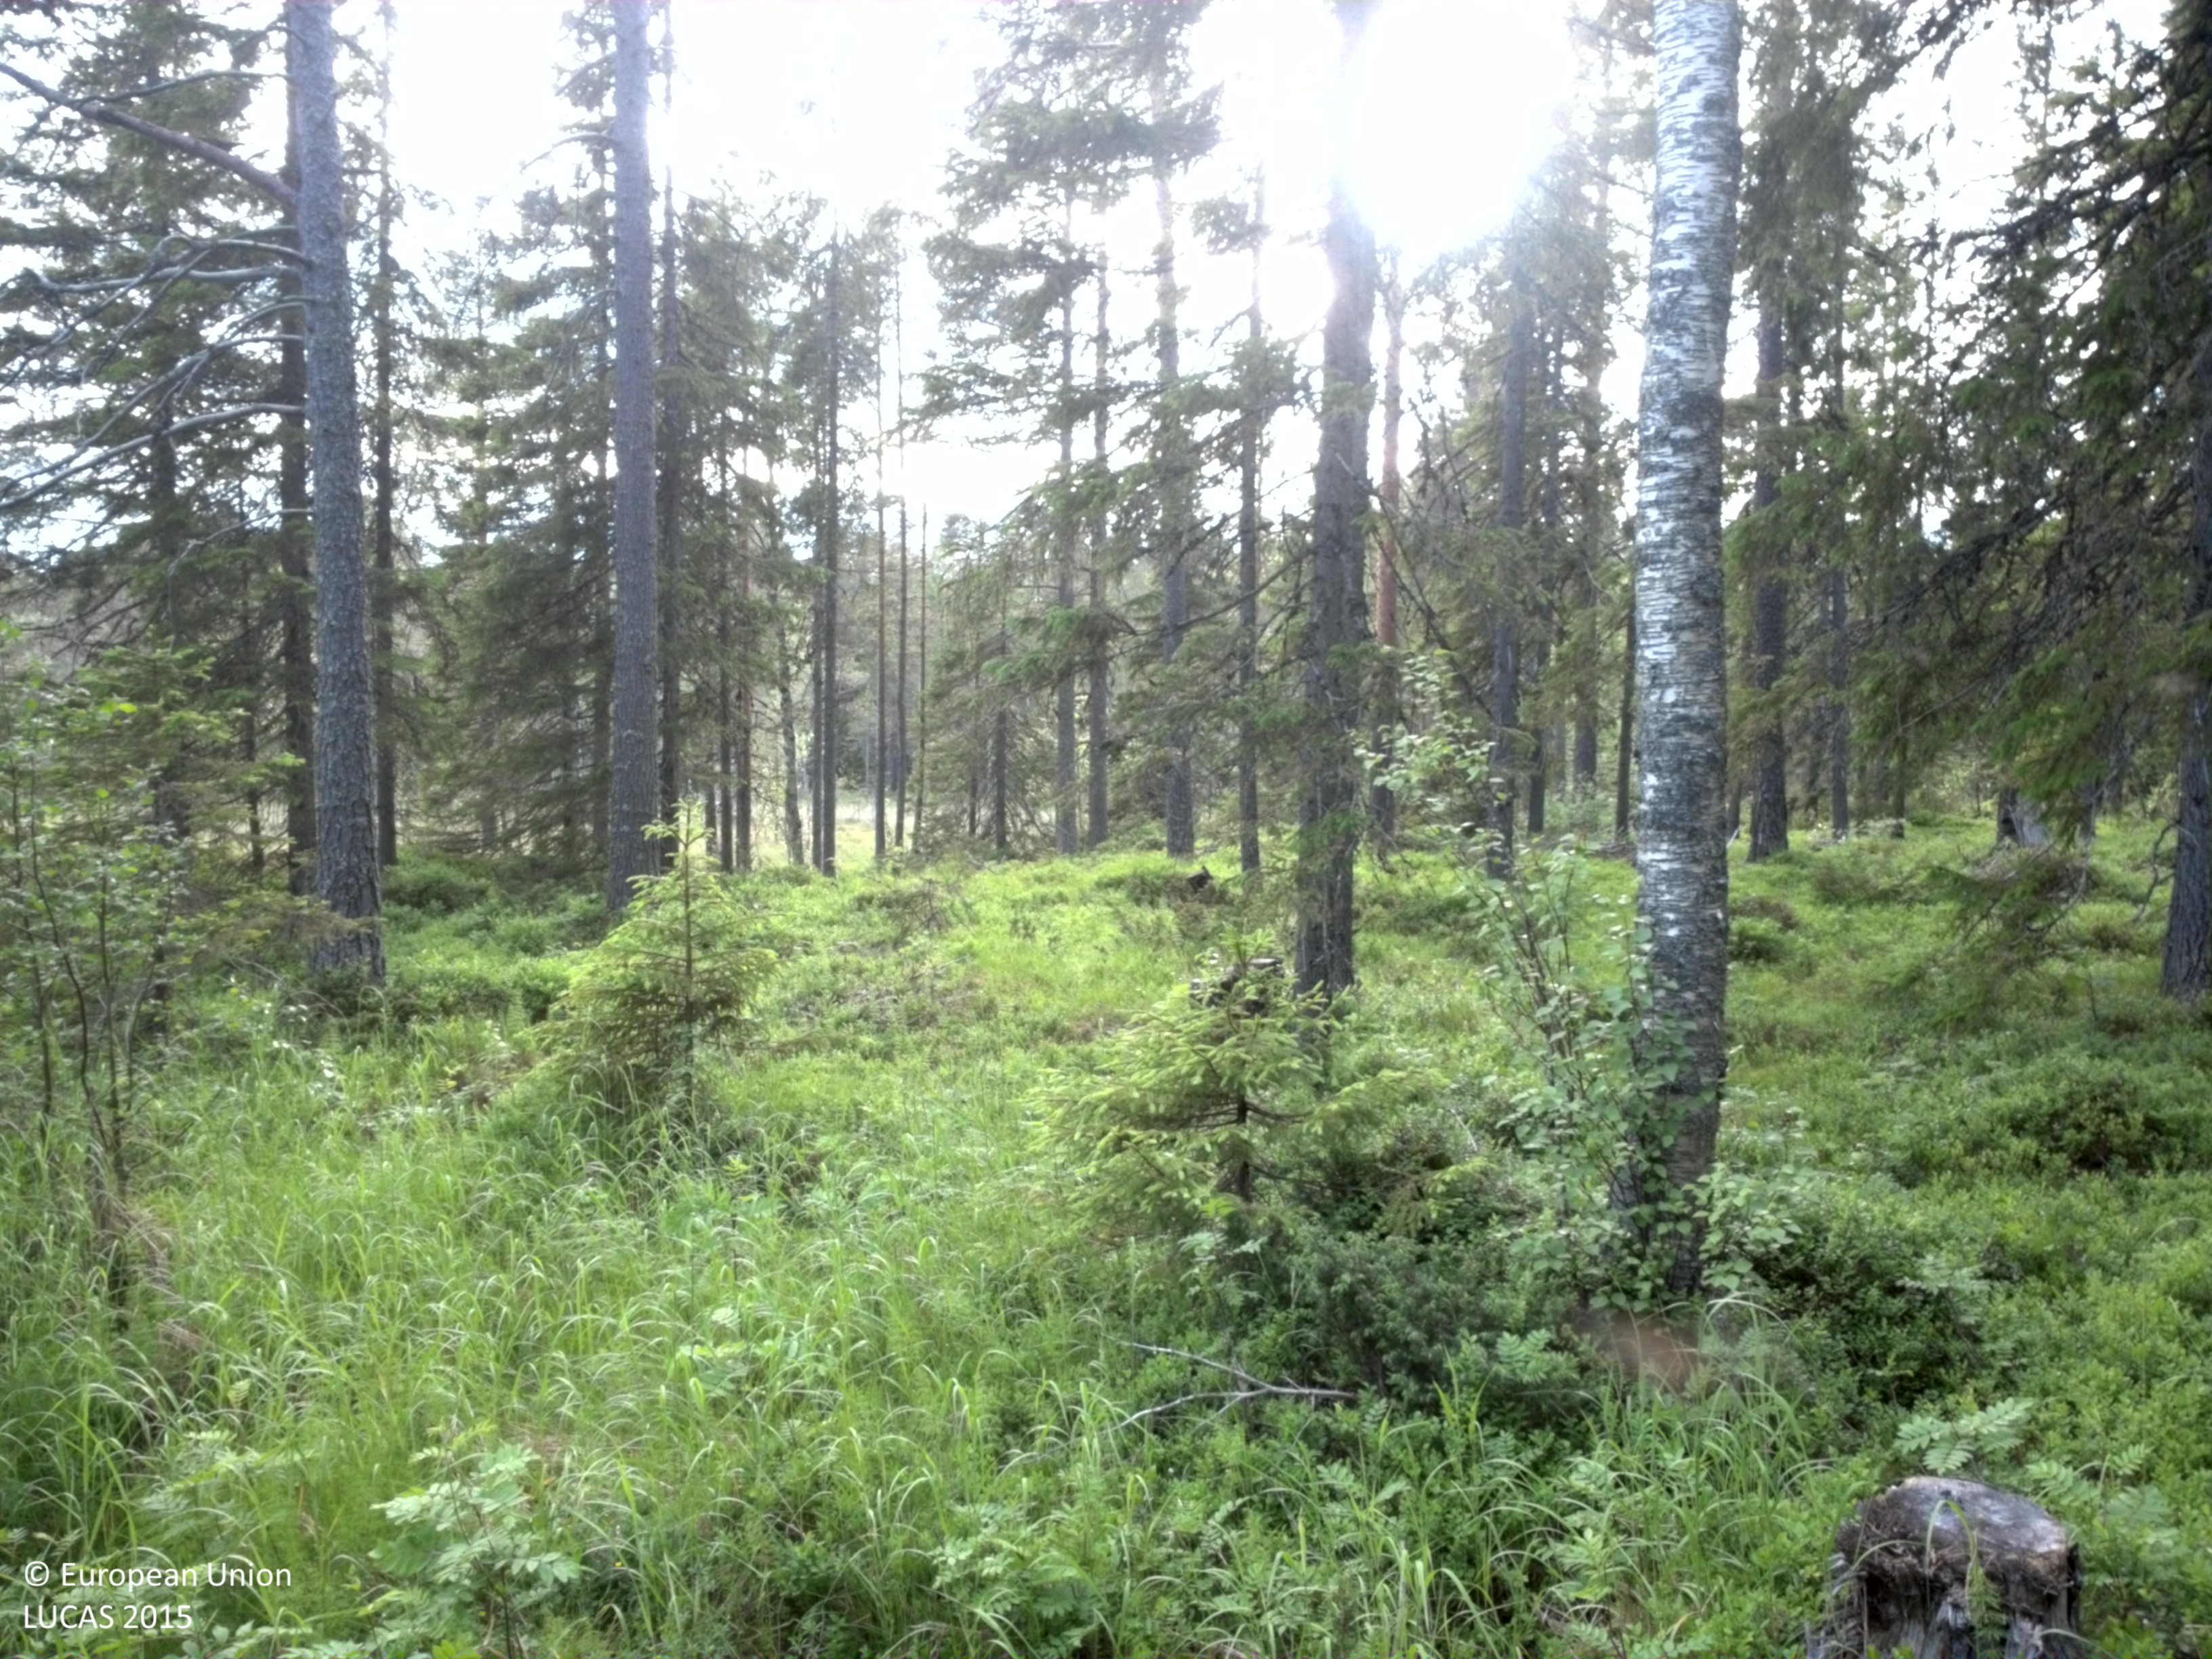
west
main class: Woodland
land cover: Other coniferous woodland
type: boreal forest
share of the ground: 25 - 50 %
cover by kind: coniferous forest trees 50 %, shrubs 30 %
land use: Forestry
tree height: > 5 m
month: July
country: SE
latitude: 64.3266
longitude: 20.7172
